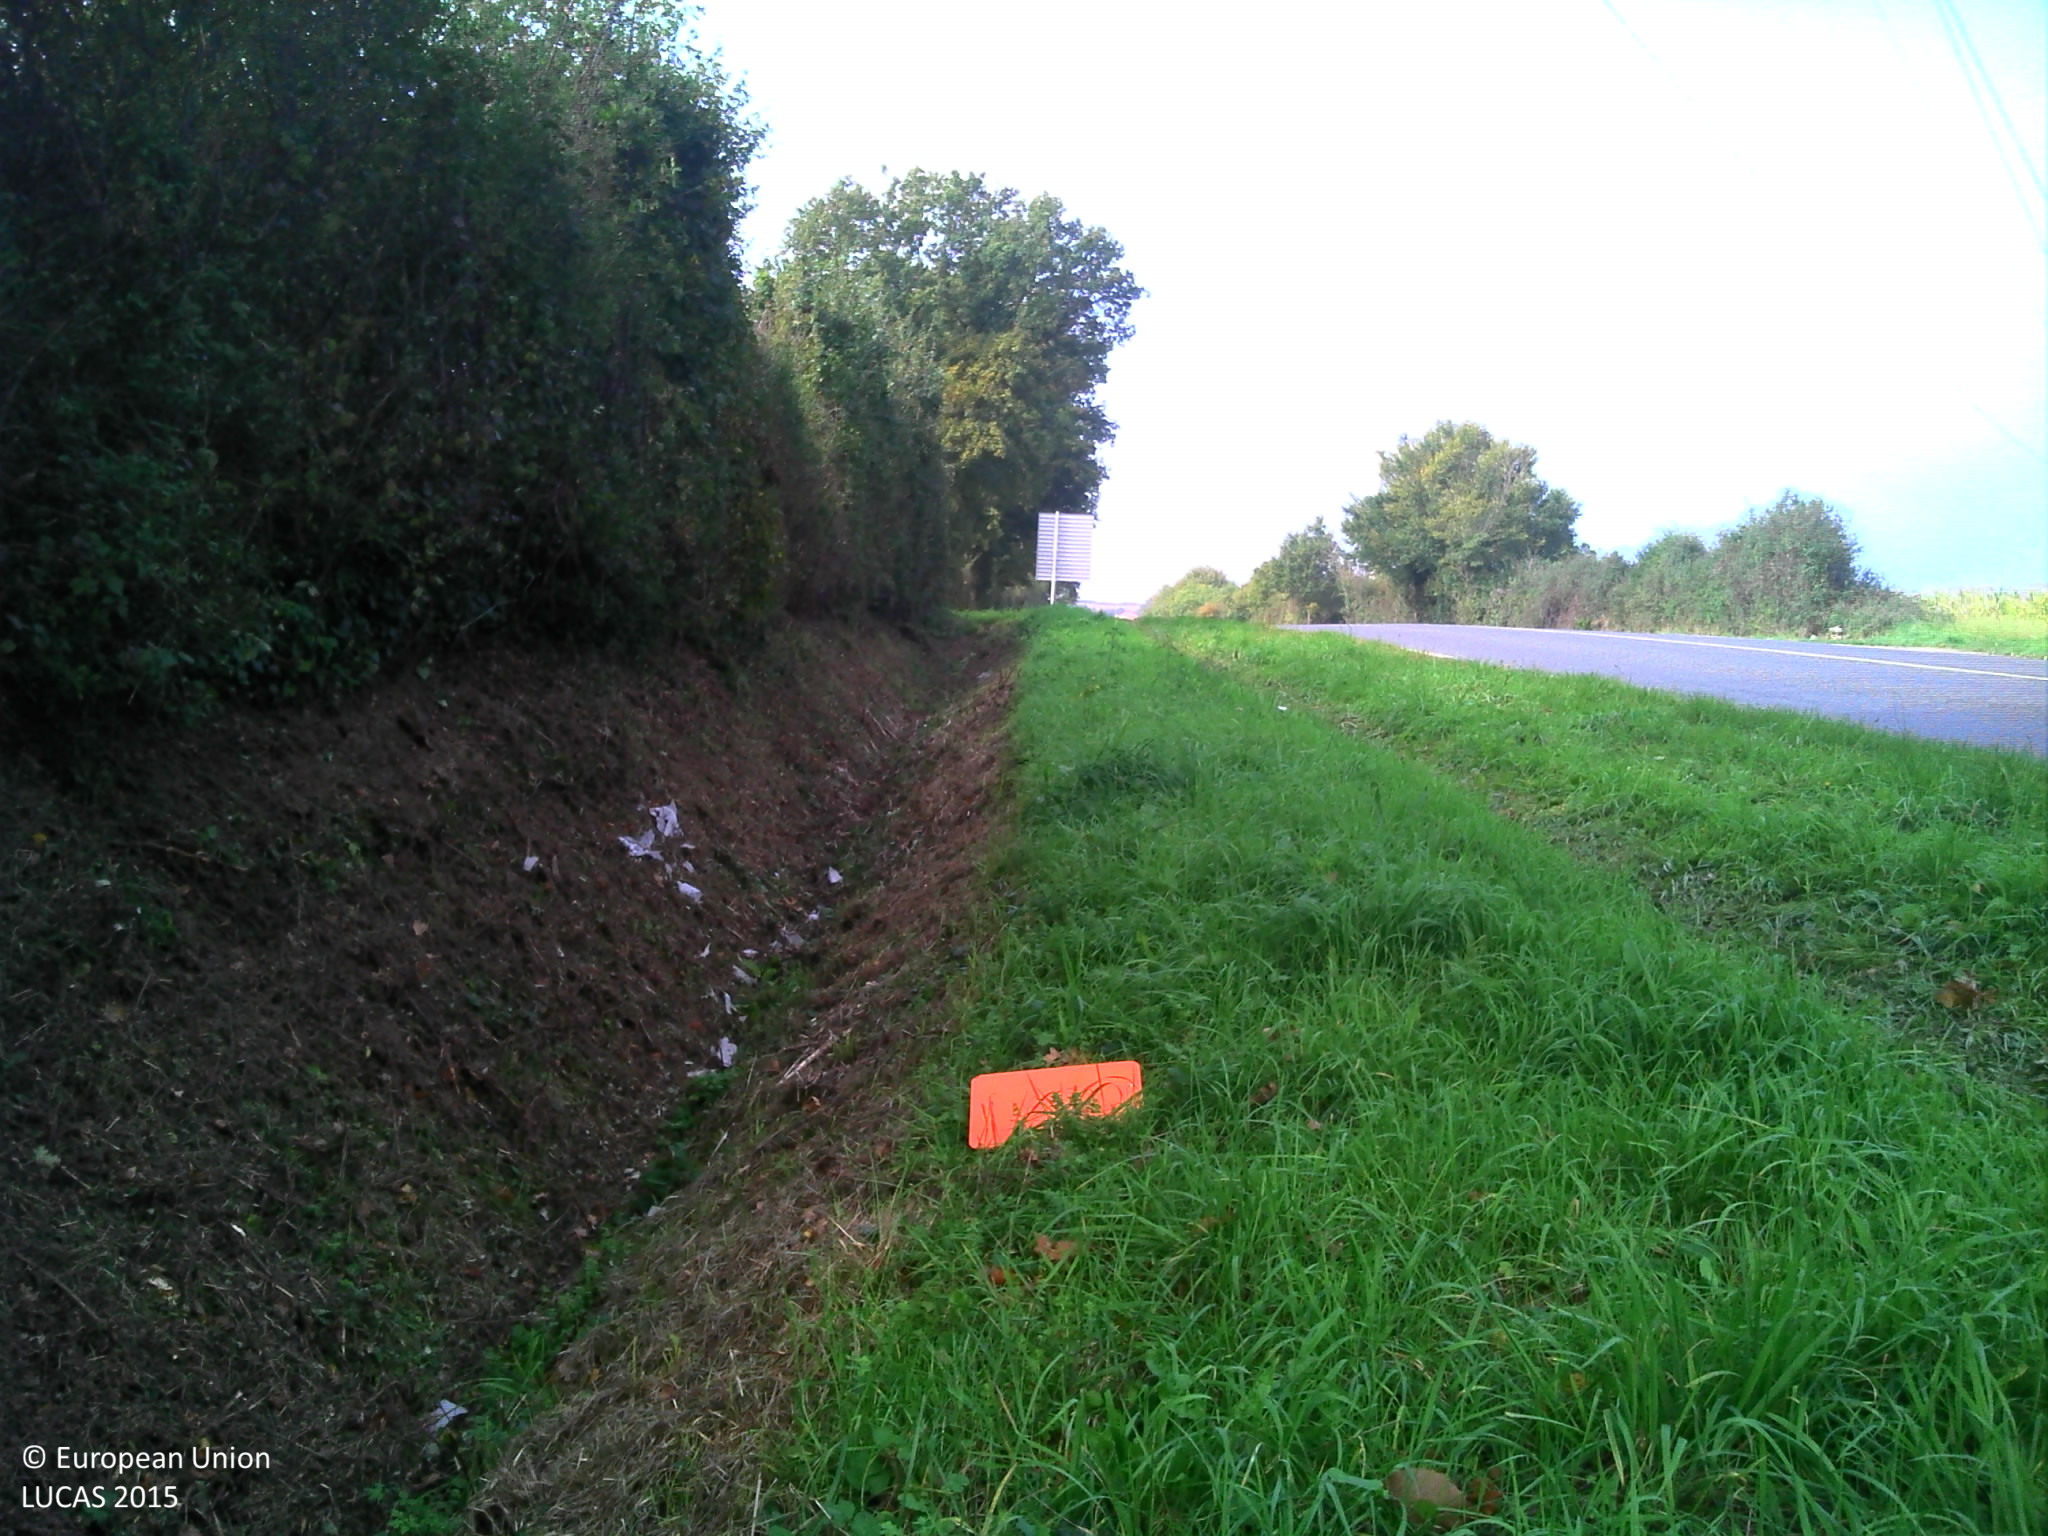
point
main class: Grassland
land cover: Grassland without tree/shrub cover
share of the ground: > 75 %
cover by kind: herbaceous plants 100 %
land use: Road transport
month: October
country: FR
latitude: 47.0591
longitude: -0.9483
